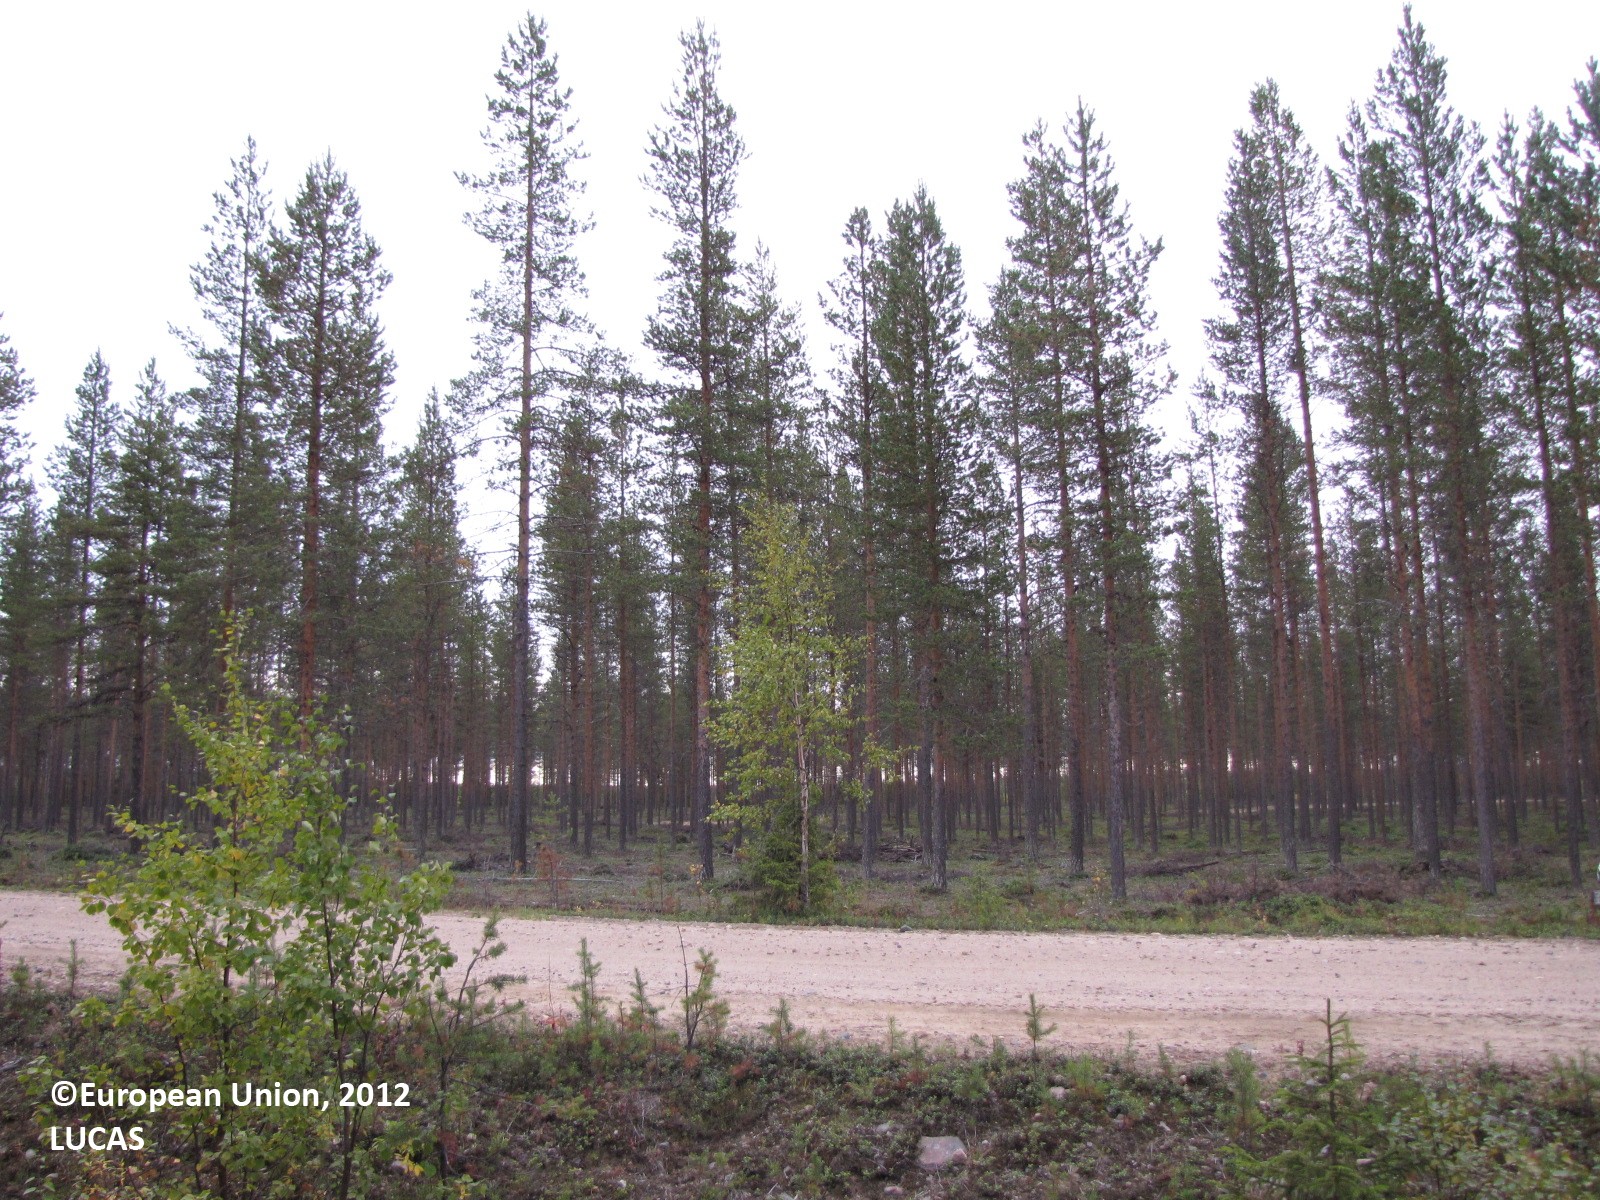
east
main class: Woodland
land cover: Pine dominated coniferous woodland
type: boreal forest
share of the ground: 50 - 75 %
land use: Forestry
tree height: > 5 m
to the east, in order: Pine dominated coniferous woodland; Ditches and canals; Abandoned hedges; Shruby margins; Paved roads, cycling and walking lanes; Shruby margins; Ditches and canals; Pine dominated coniferous woodland; Paved roads, cycling and walking lanes; Pine dominated coniferous woodland; Tracks; Other mixed woodland
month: September
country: FI
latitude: 67.2083
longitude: 24.8223
